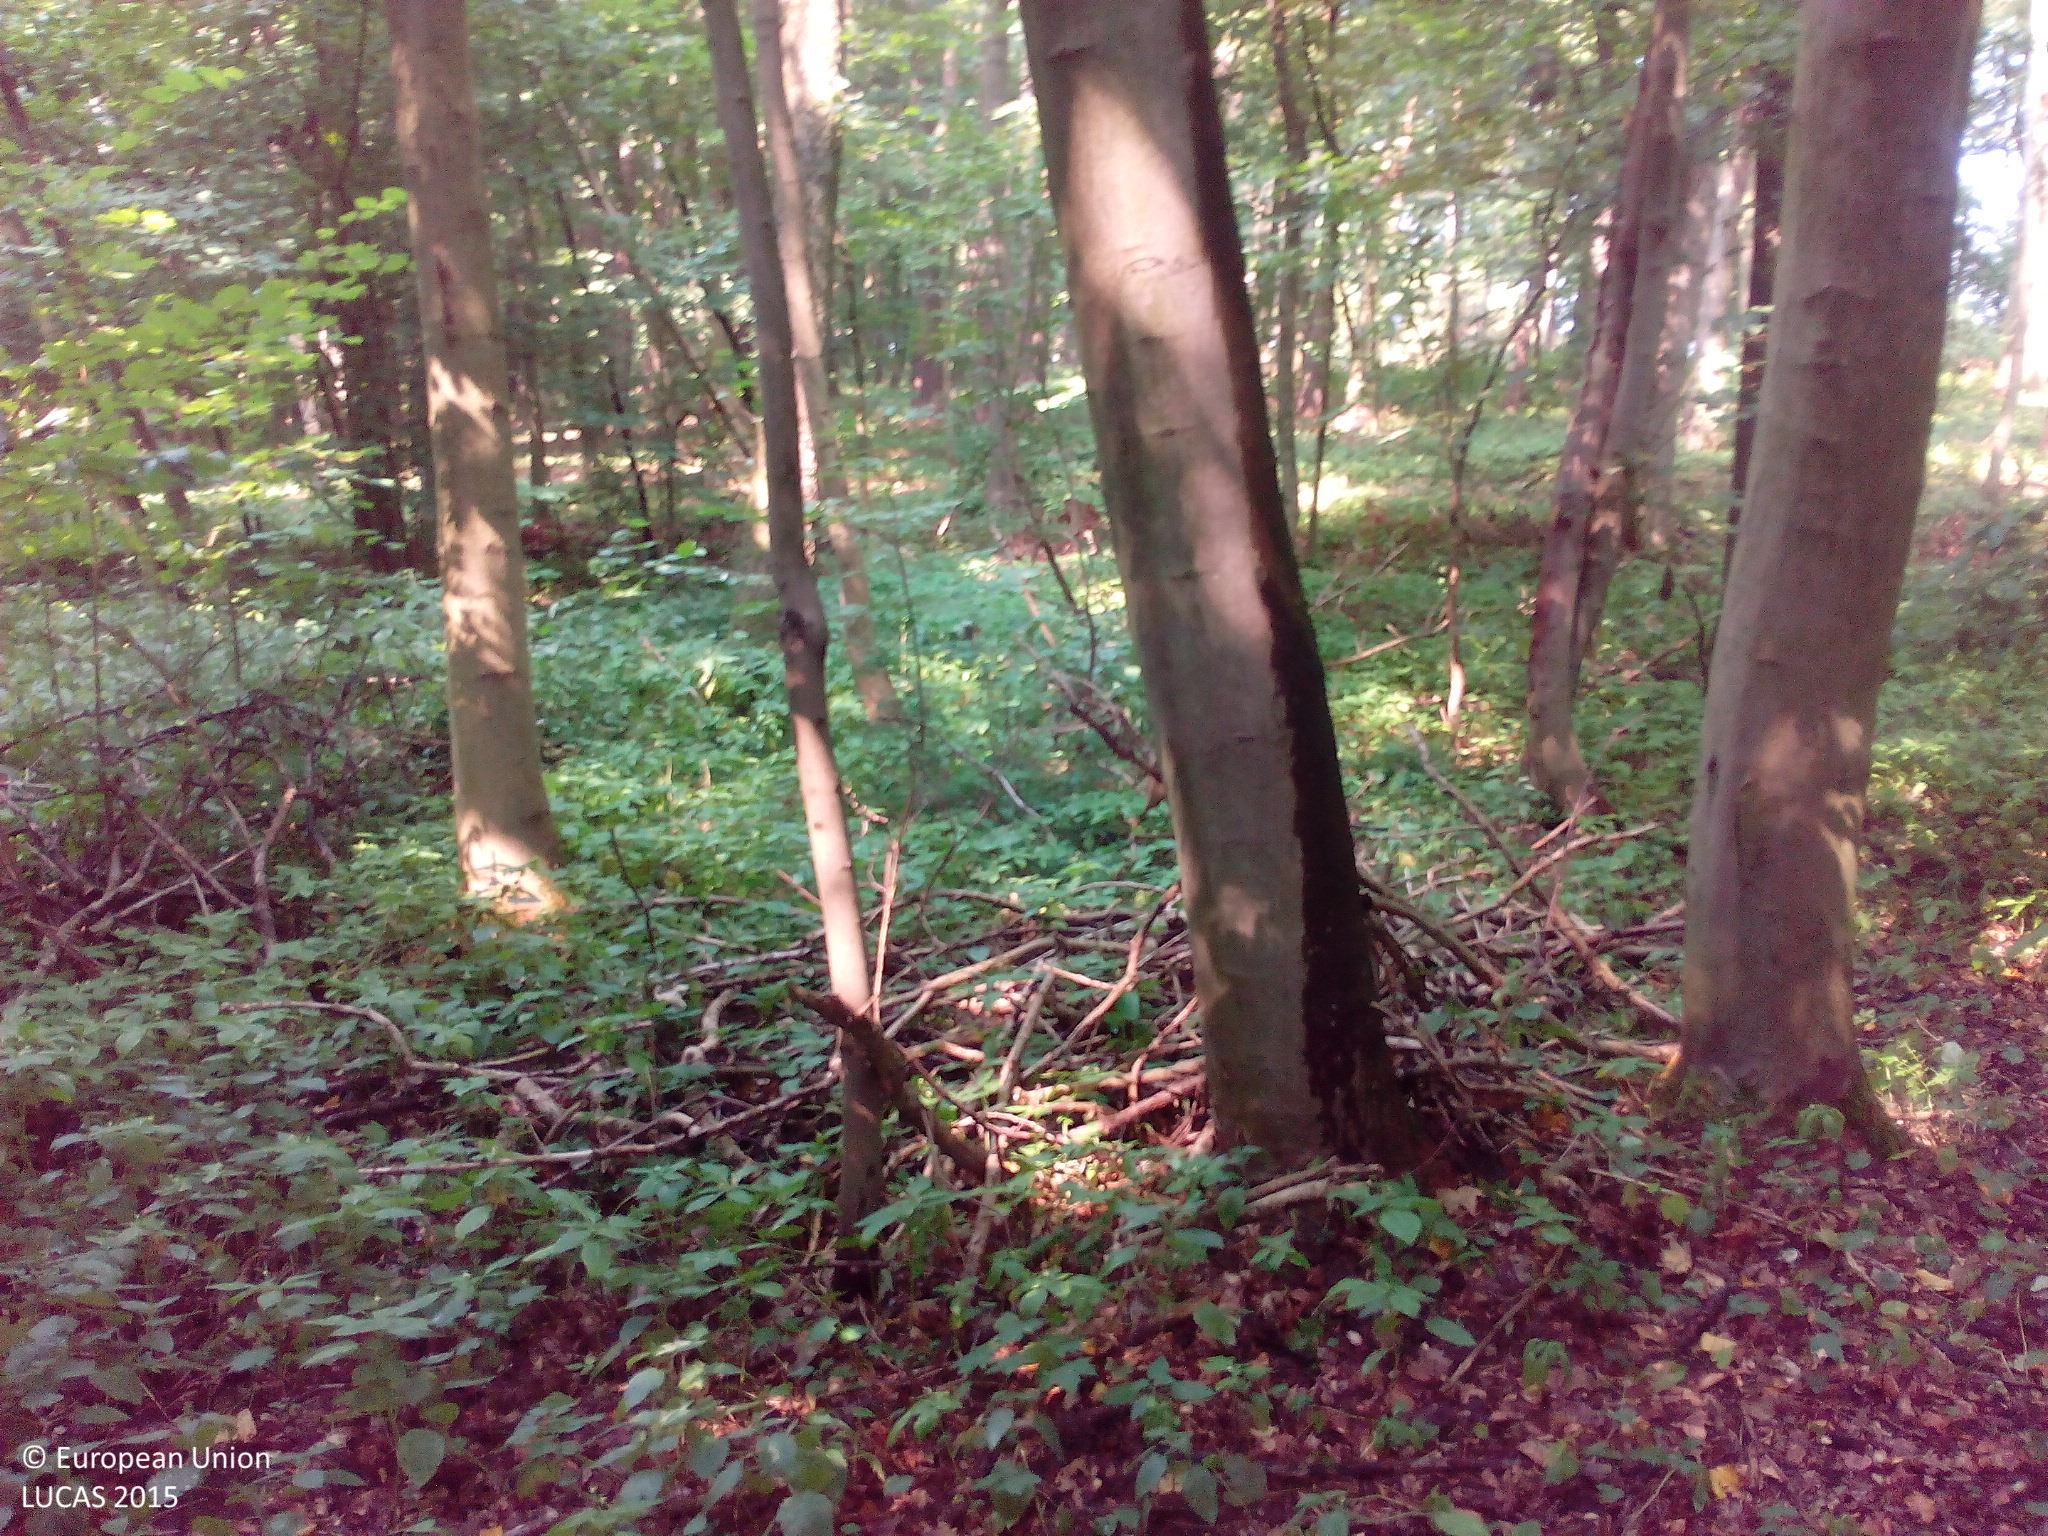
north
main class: Woodland
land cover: Broadleaved woodland
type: mesophytic deciduous forest
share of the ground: > 75 %
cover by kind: broadleaved forest trees 95 %, herbaceous plants 5 %
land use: Forestry
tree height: > 5 m
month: August
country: DE
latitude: 53.7938
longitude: 12.2915
